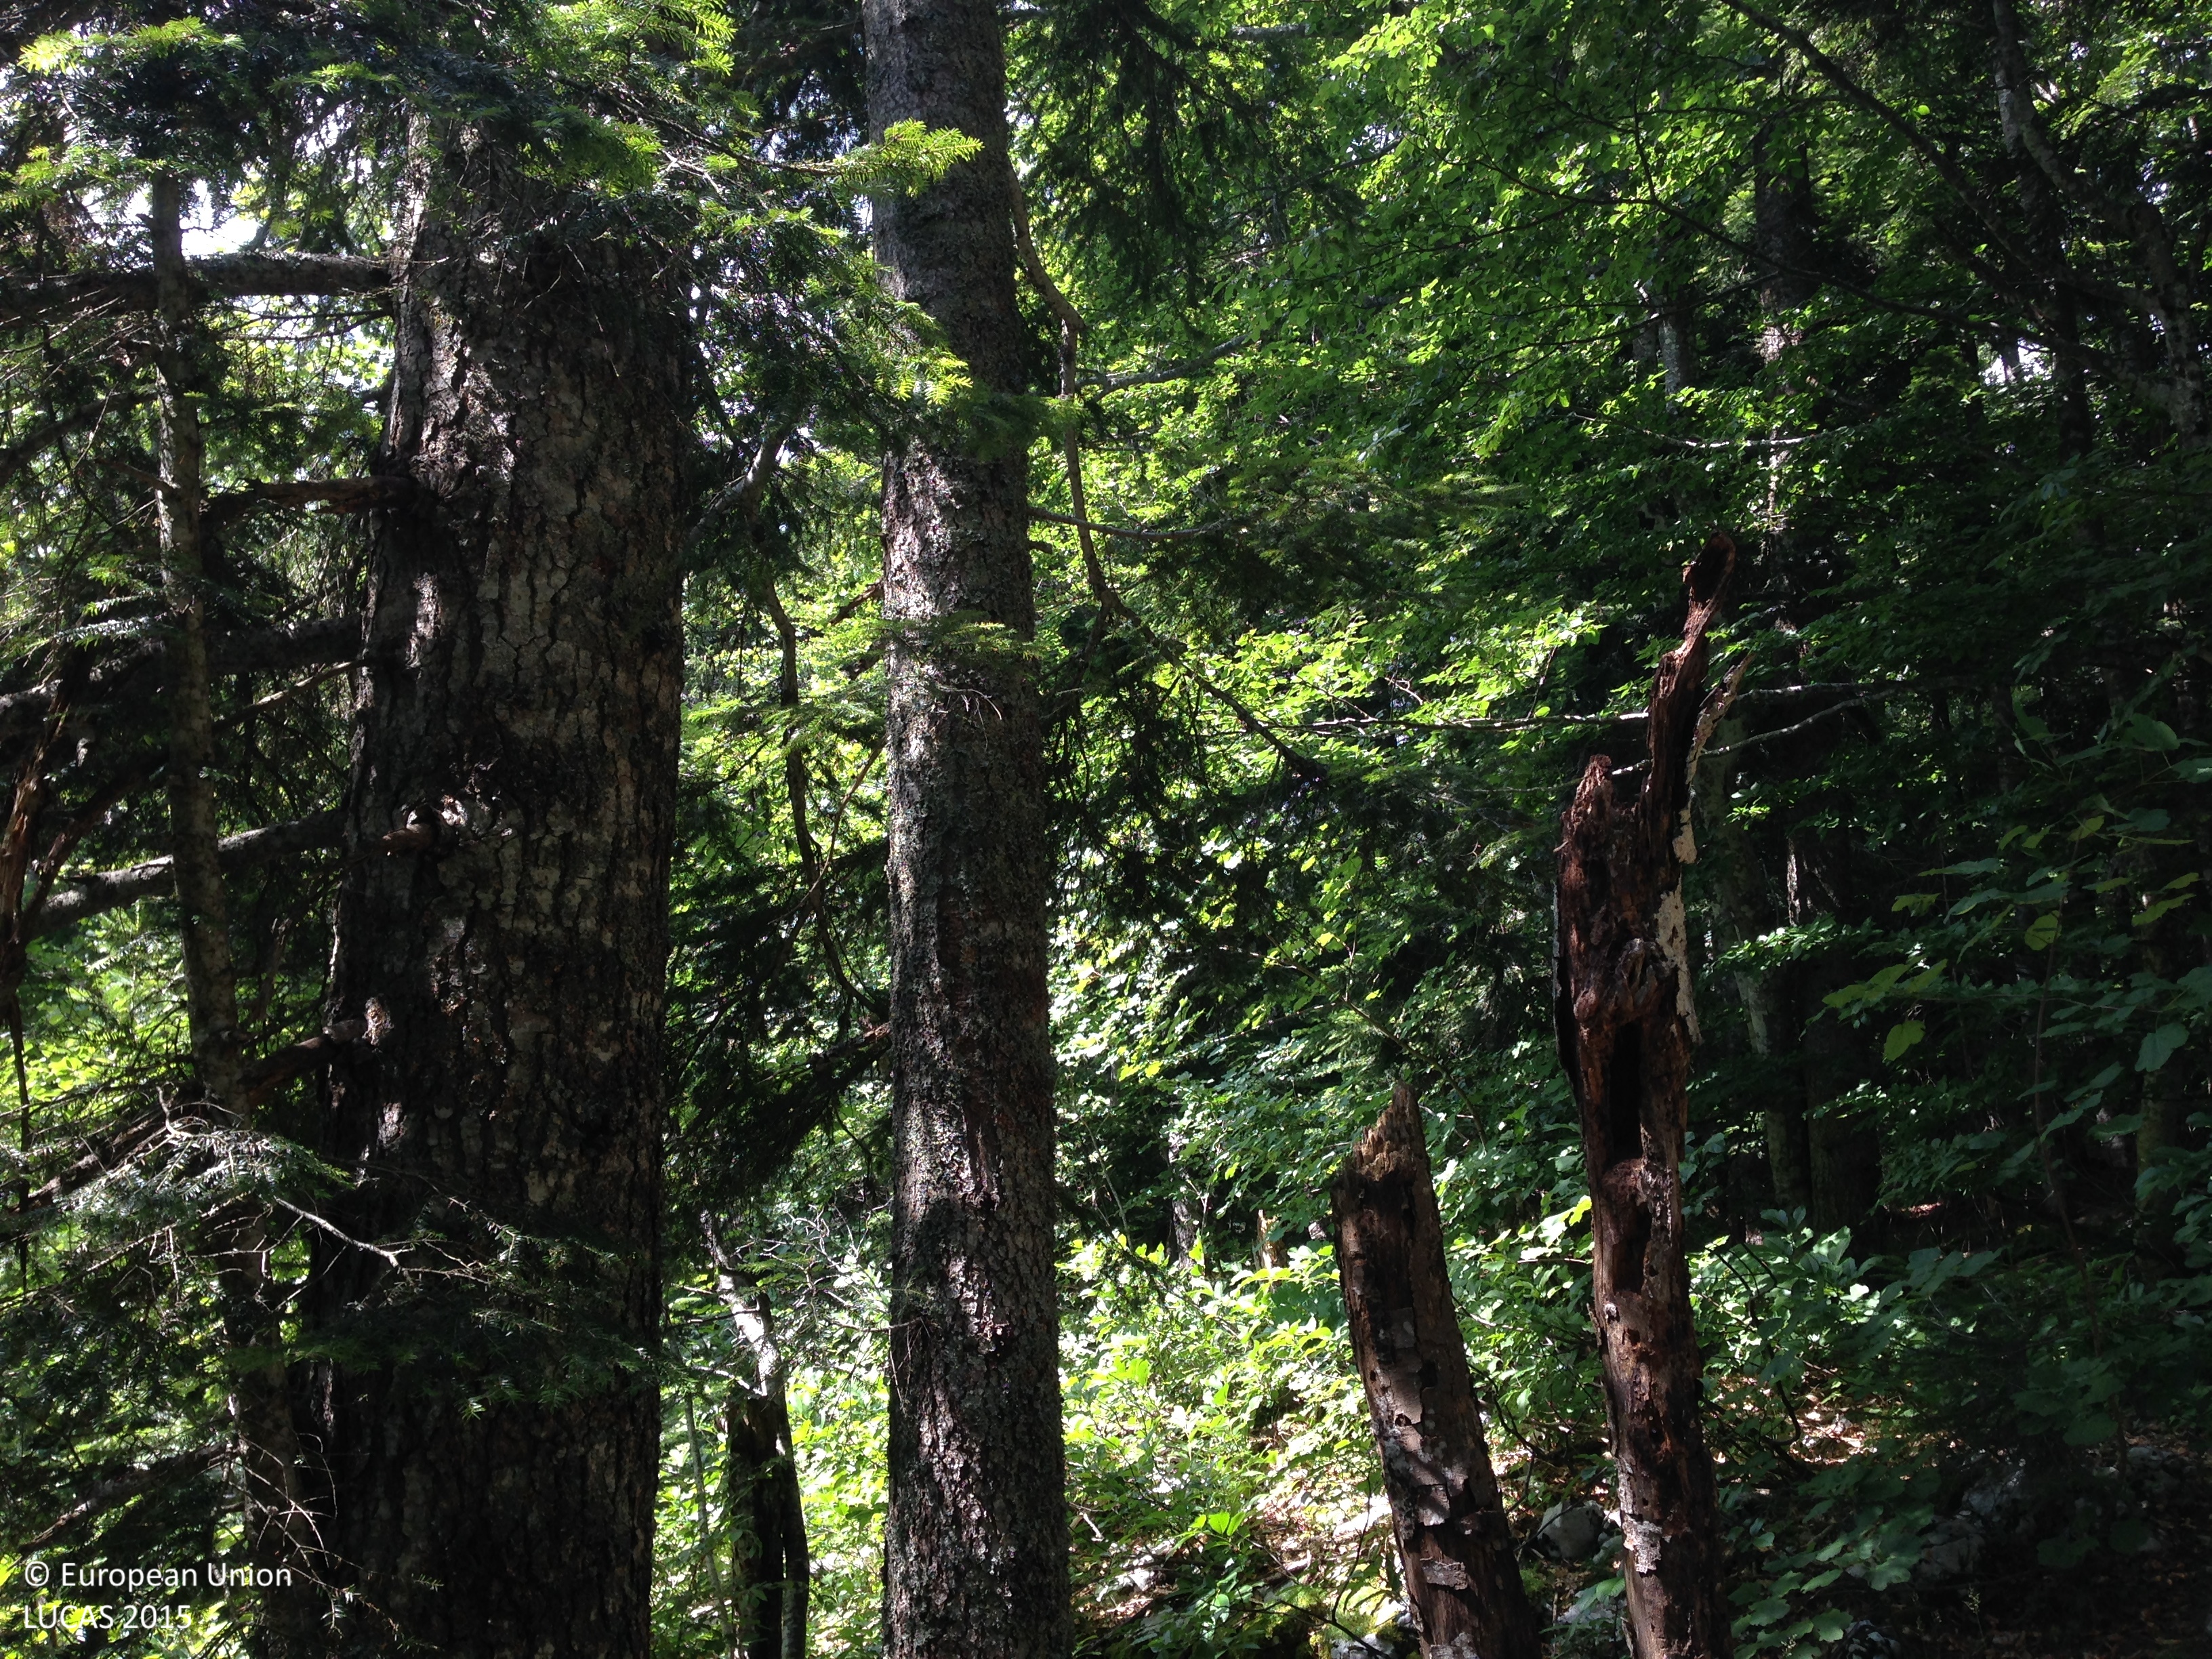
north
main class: Woodland
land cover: Other mixed woodland
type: mountainous beech forest
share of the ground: > 75 %
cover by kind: coniferous forest trees 40 %, broadleaved forest trees 30 %, herbaceous plants 20 %, shrubs 5 %, consolidated bare surface 5 %
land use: Forestry
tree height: > 5 m
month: June
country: HR
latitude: 44.7892
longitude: 15.7202
